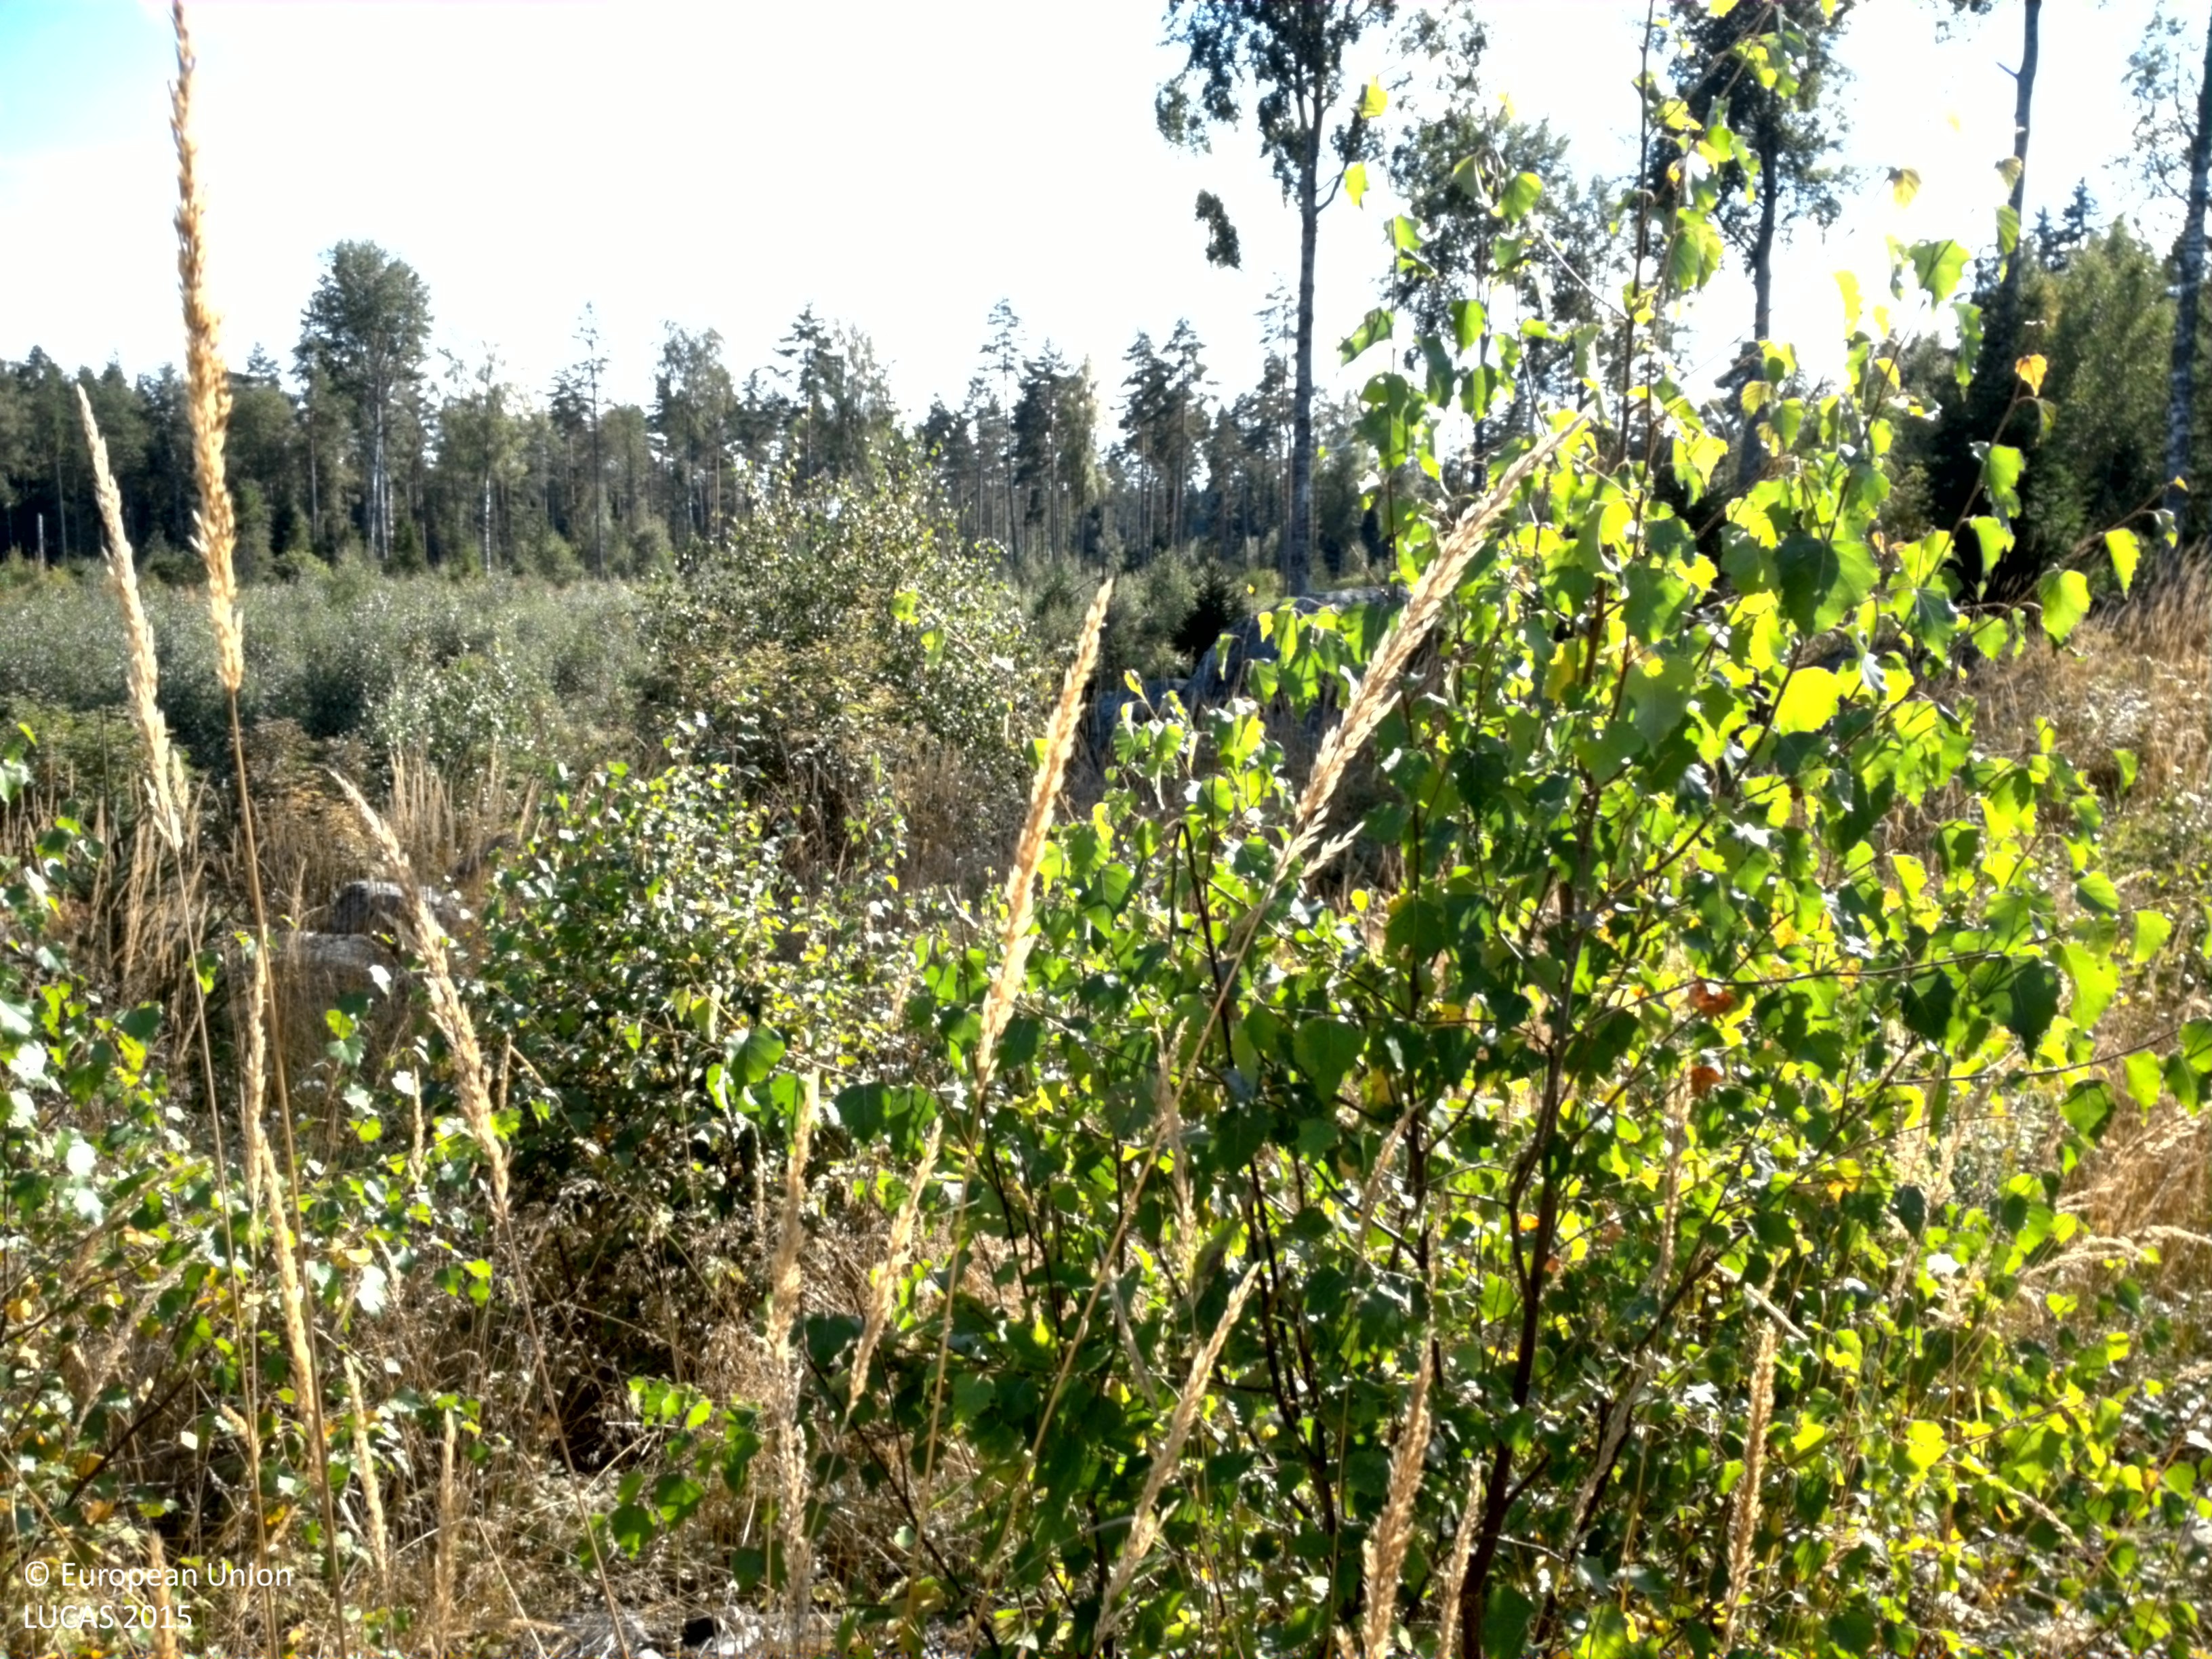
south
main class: Woodland
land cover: Broadleaved woodland
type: boreal forest
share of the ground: 25 - 50 %
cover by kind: herbaceous plants 45 %, broadleaved forest trees 30 %, shrubs 15 %, coniferous forest trees 5 %, consolidated bare surface 5 %
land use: Forestry
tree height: < 5 m
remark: Clear cut
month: August
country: SE
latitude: 60.0964
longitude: 17.7080
